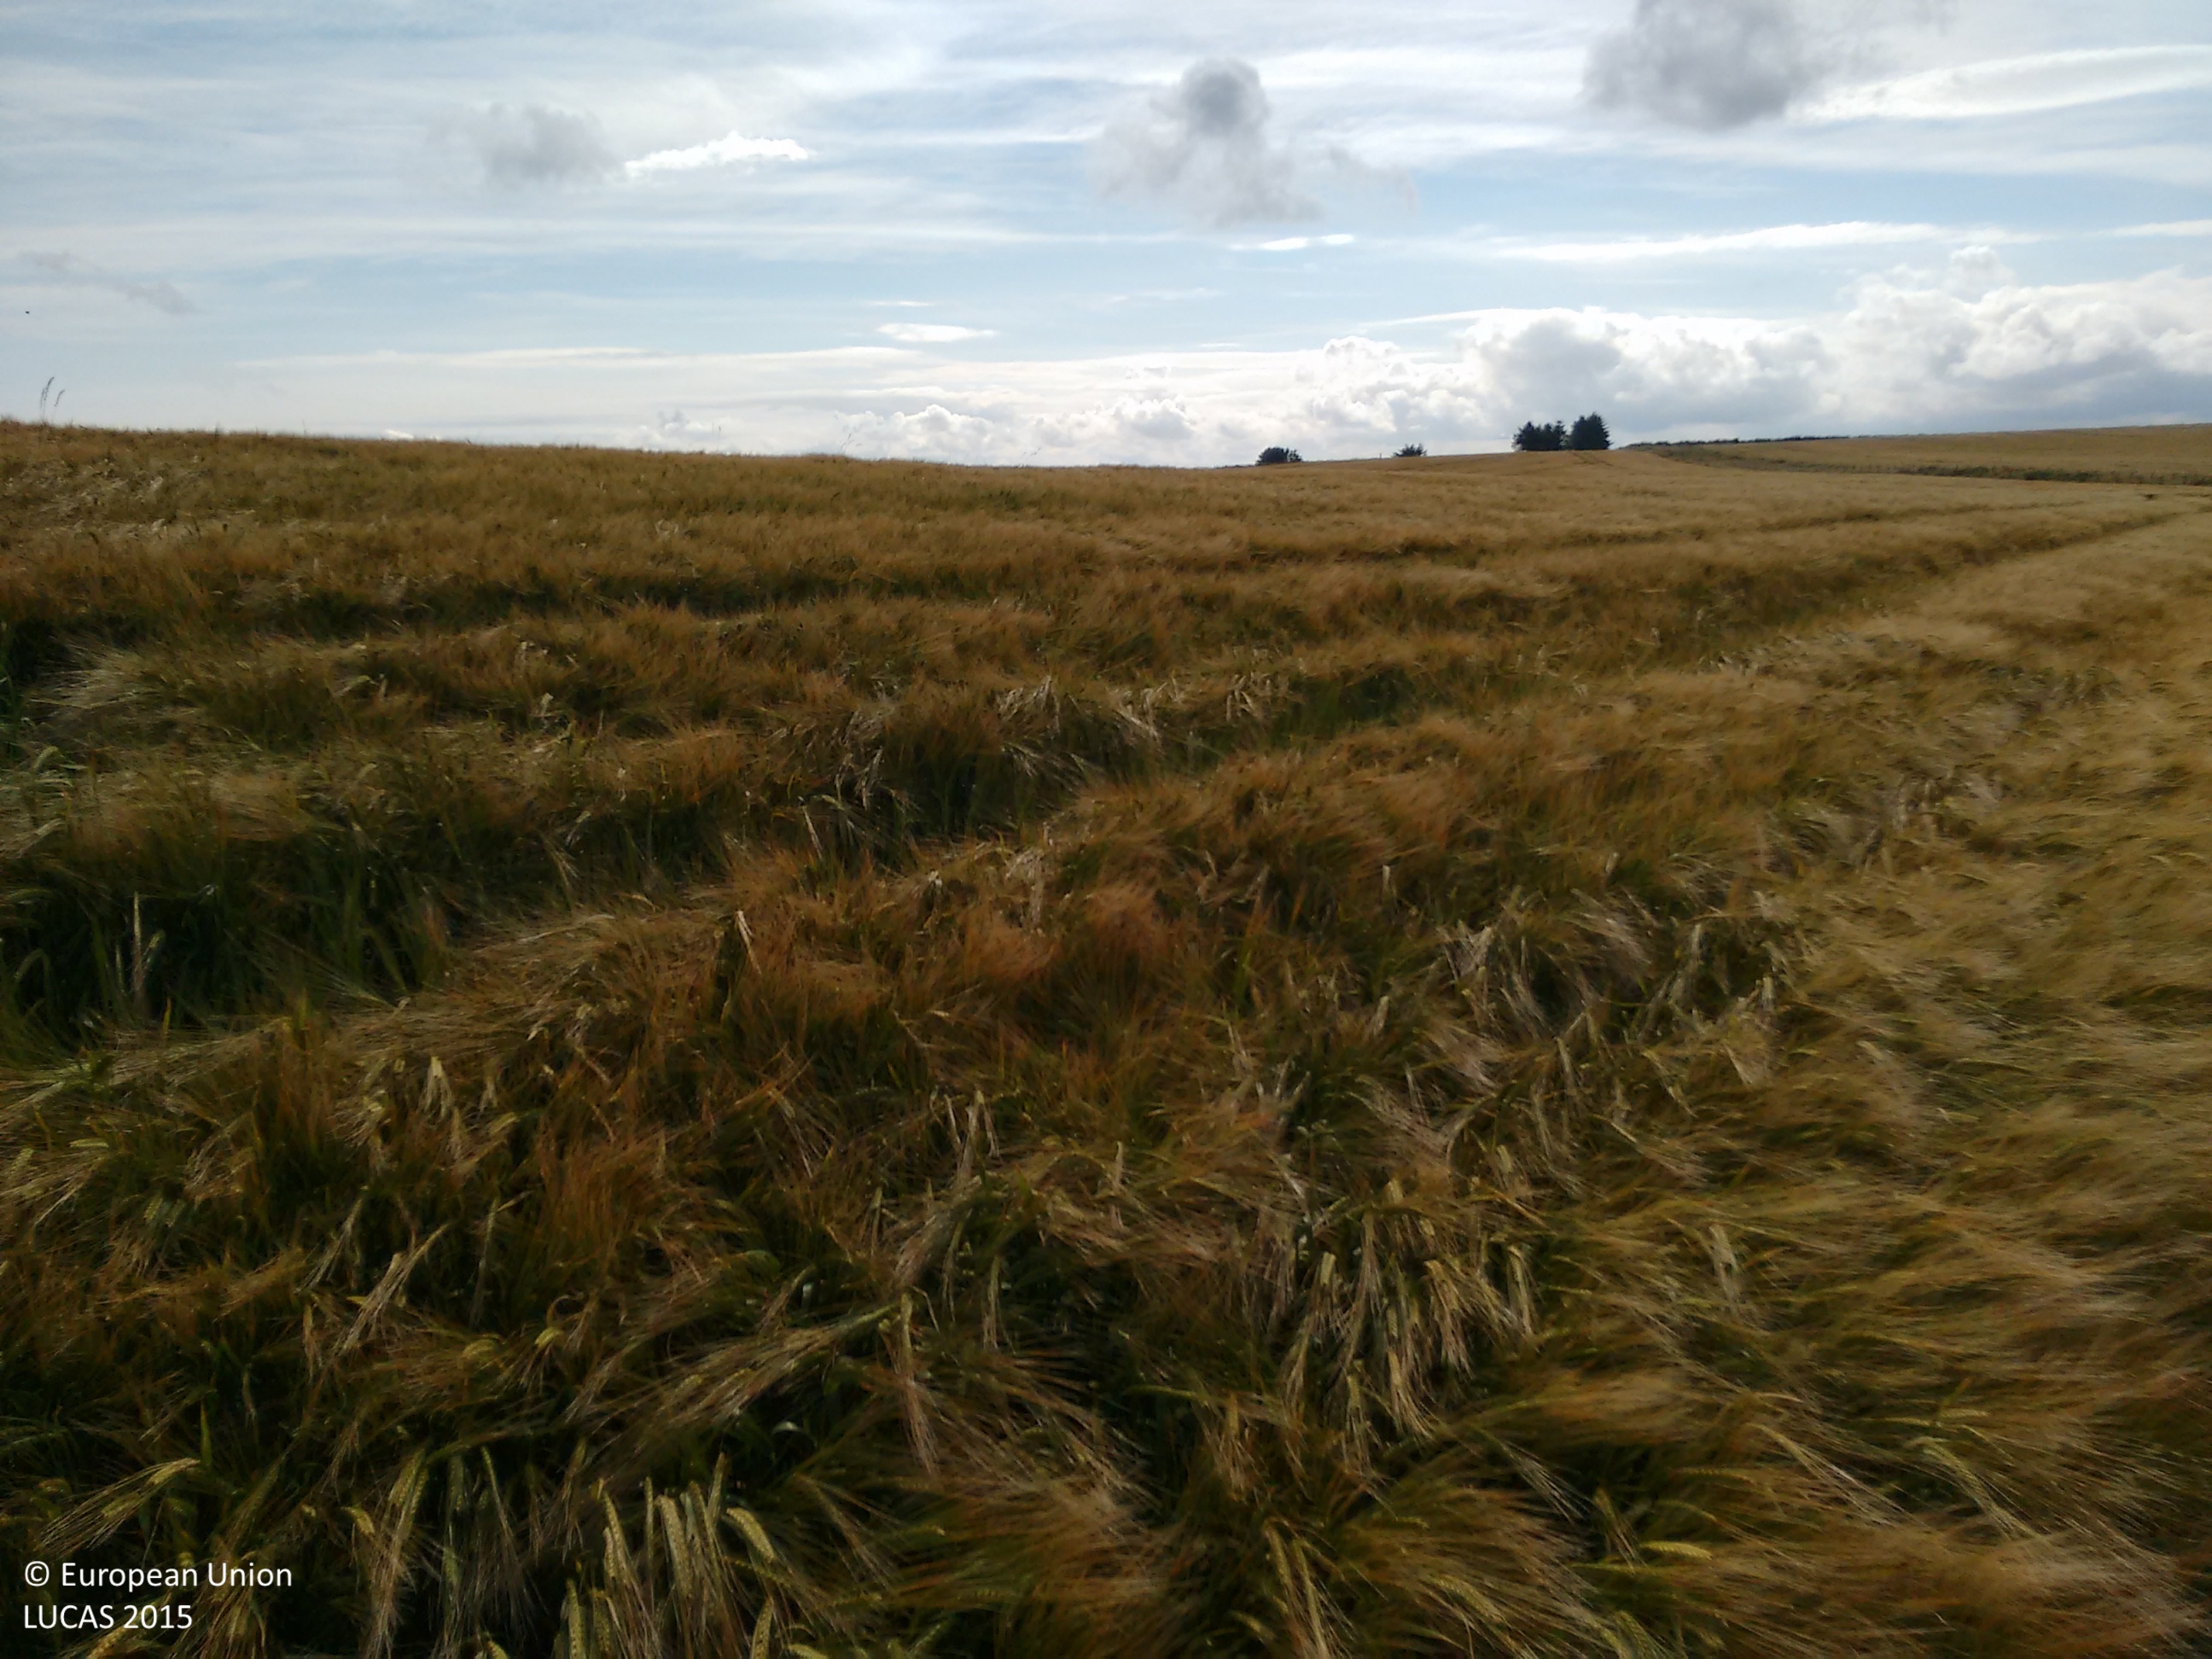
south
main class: Cropland
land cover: Barley
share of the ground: > 75 %
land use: Agriculture (excluding fallow land and kitchen gardens)
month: August
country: GB
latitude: 57.5698
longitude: -2.2026
